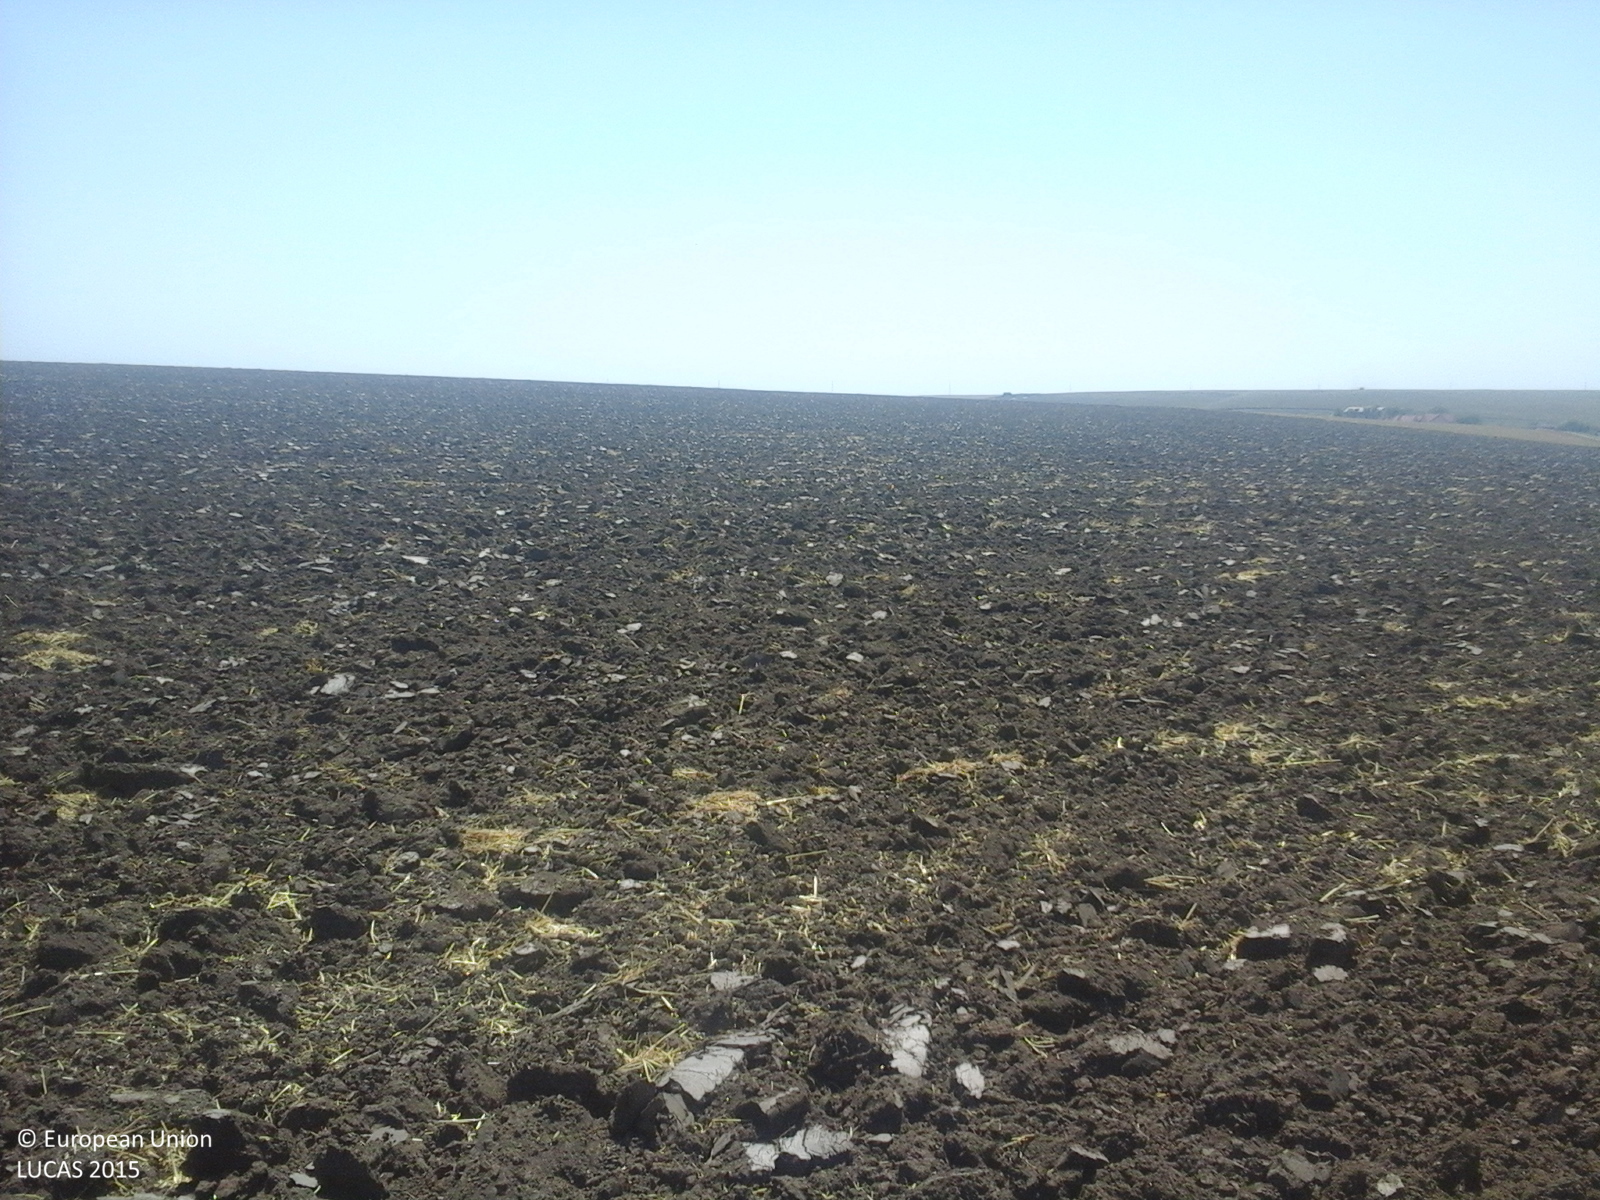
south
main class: Cropland
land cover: Durum wheat
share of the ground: < 10 %
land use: Agriculture (excluding fallow land and kitchen gardens)
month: July
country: RO
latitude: 44.4395
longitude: 26.6919
